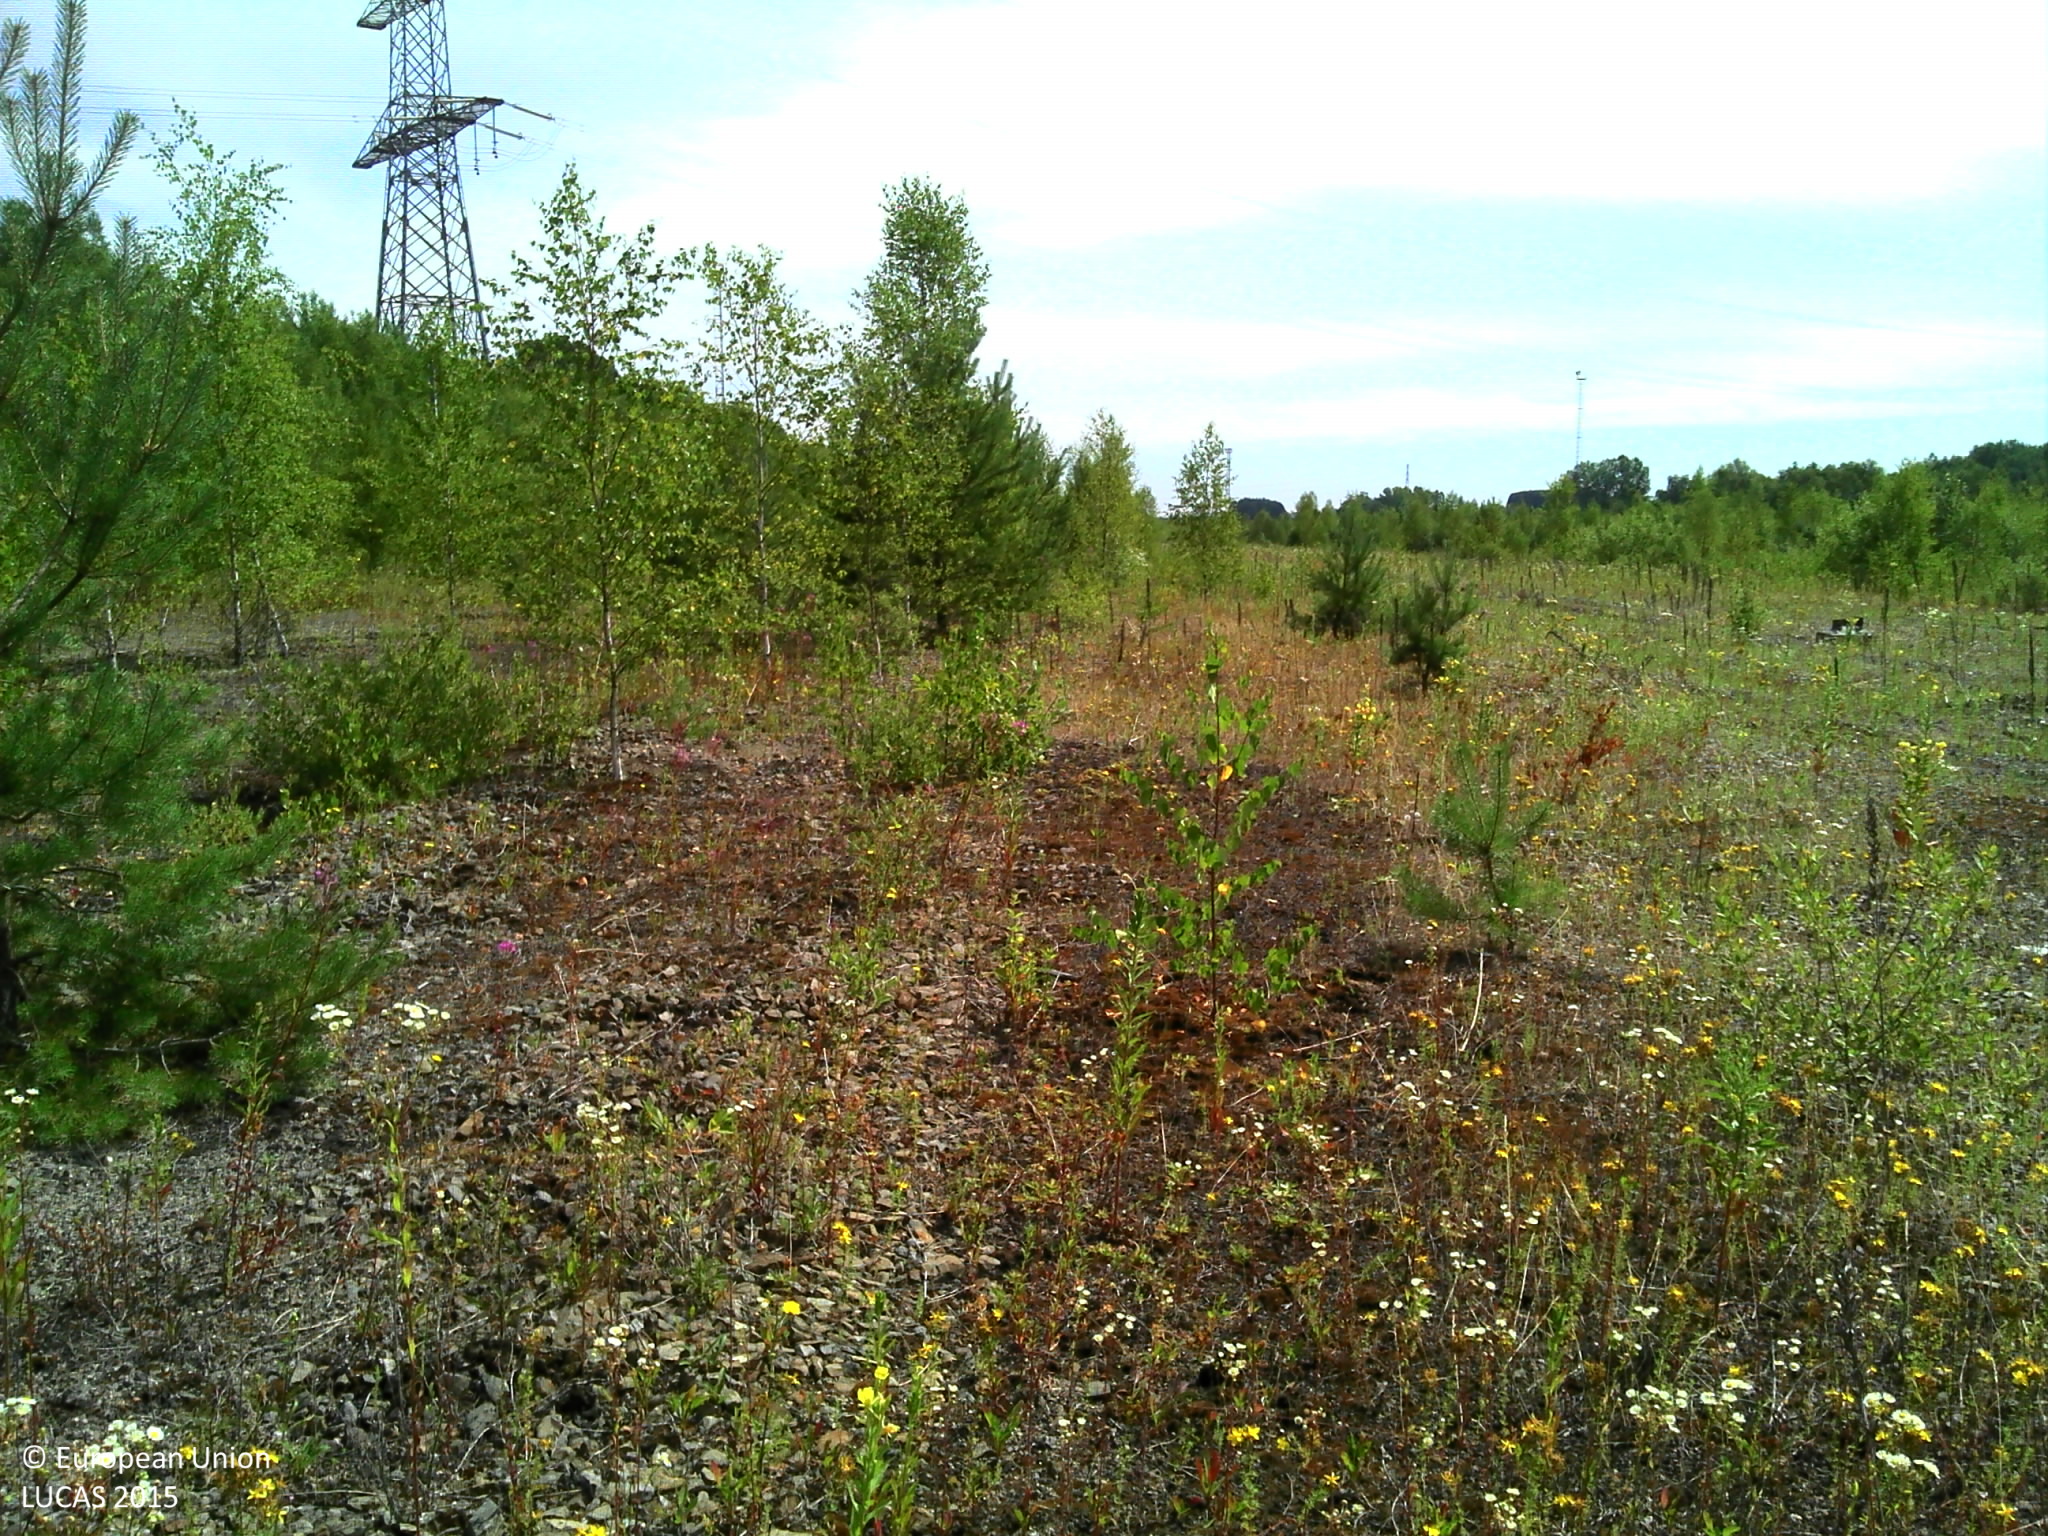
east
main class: Grassland
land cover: Spontaneously vegetated surfaces
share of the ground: 50 - 75 %
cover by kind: herbaceous plants 55 %, unconsolidated bare surface 40 %, shrubs 5 %
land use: Semi-natural and natural areas not in use
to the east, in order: Spontaneously vegetated surfaces; Shrubland without tree cover; Spontaneously vegetated surfaces; Electric lines
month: July
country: BE
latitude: 49.6906
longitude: 5.7432
